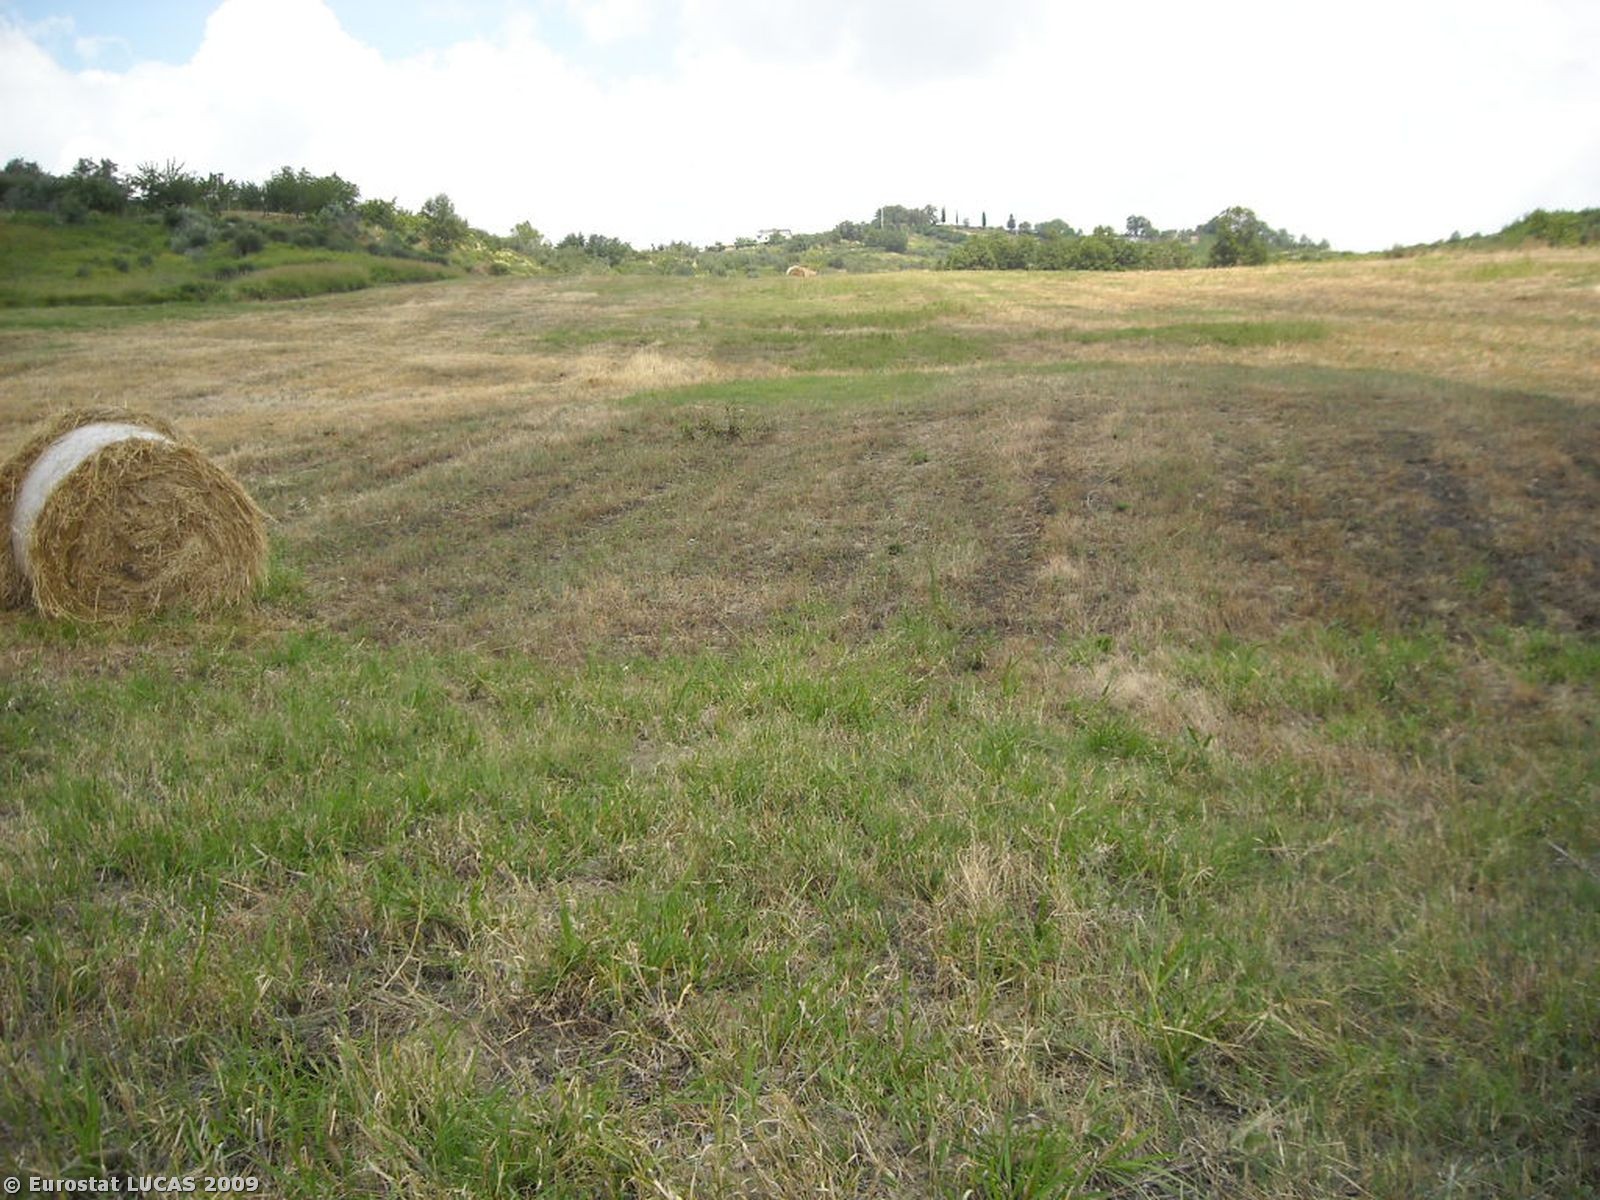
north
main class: Cropland
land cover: Mixed cereals for fodder
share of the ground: < 10 %
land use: Agriculture (excluding fallow land and kitchen gardens)
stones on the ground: < 10 %
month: July
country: IT
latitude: 40.6014
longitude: 16.1339
